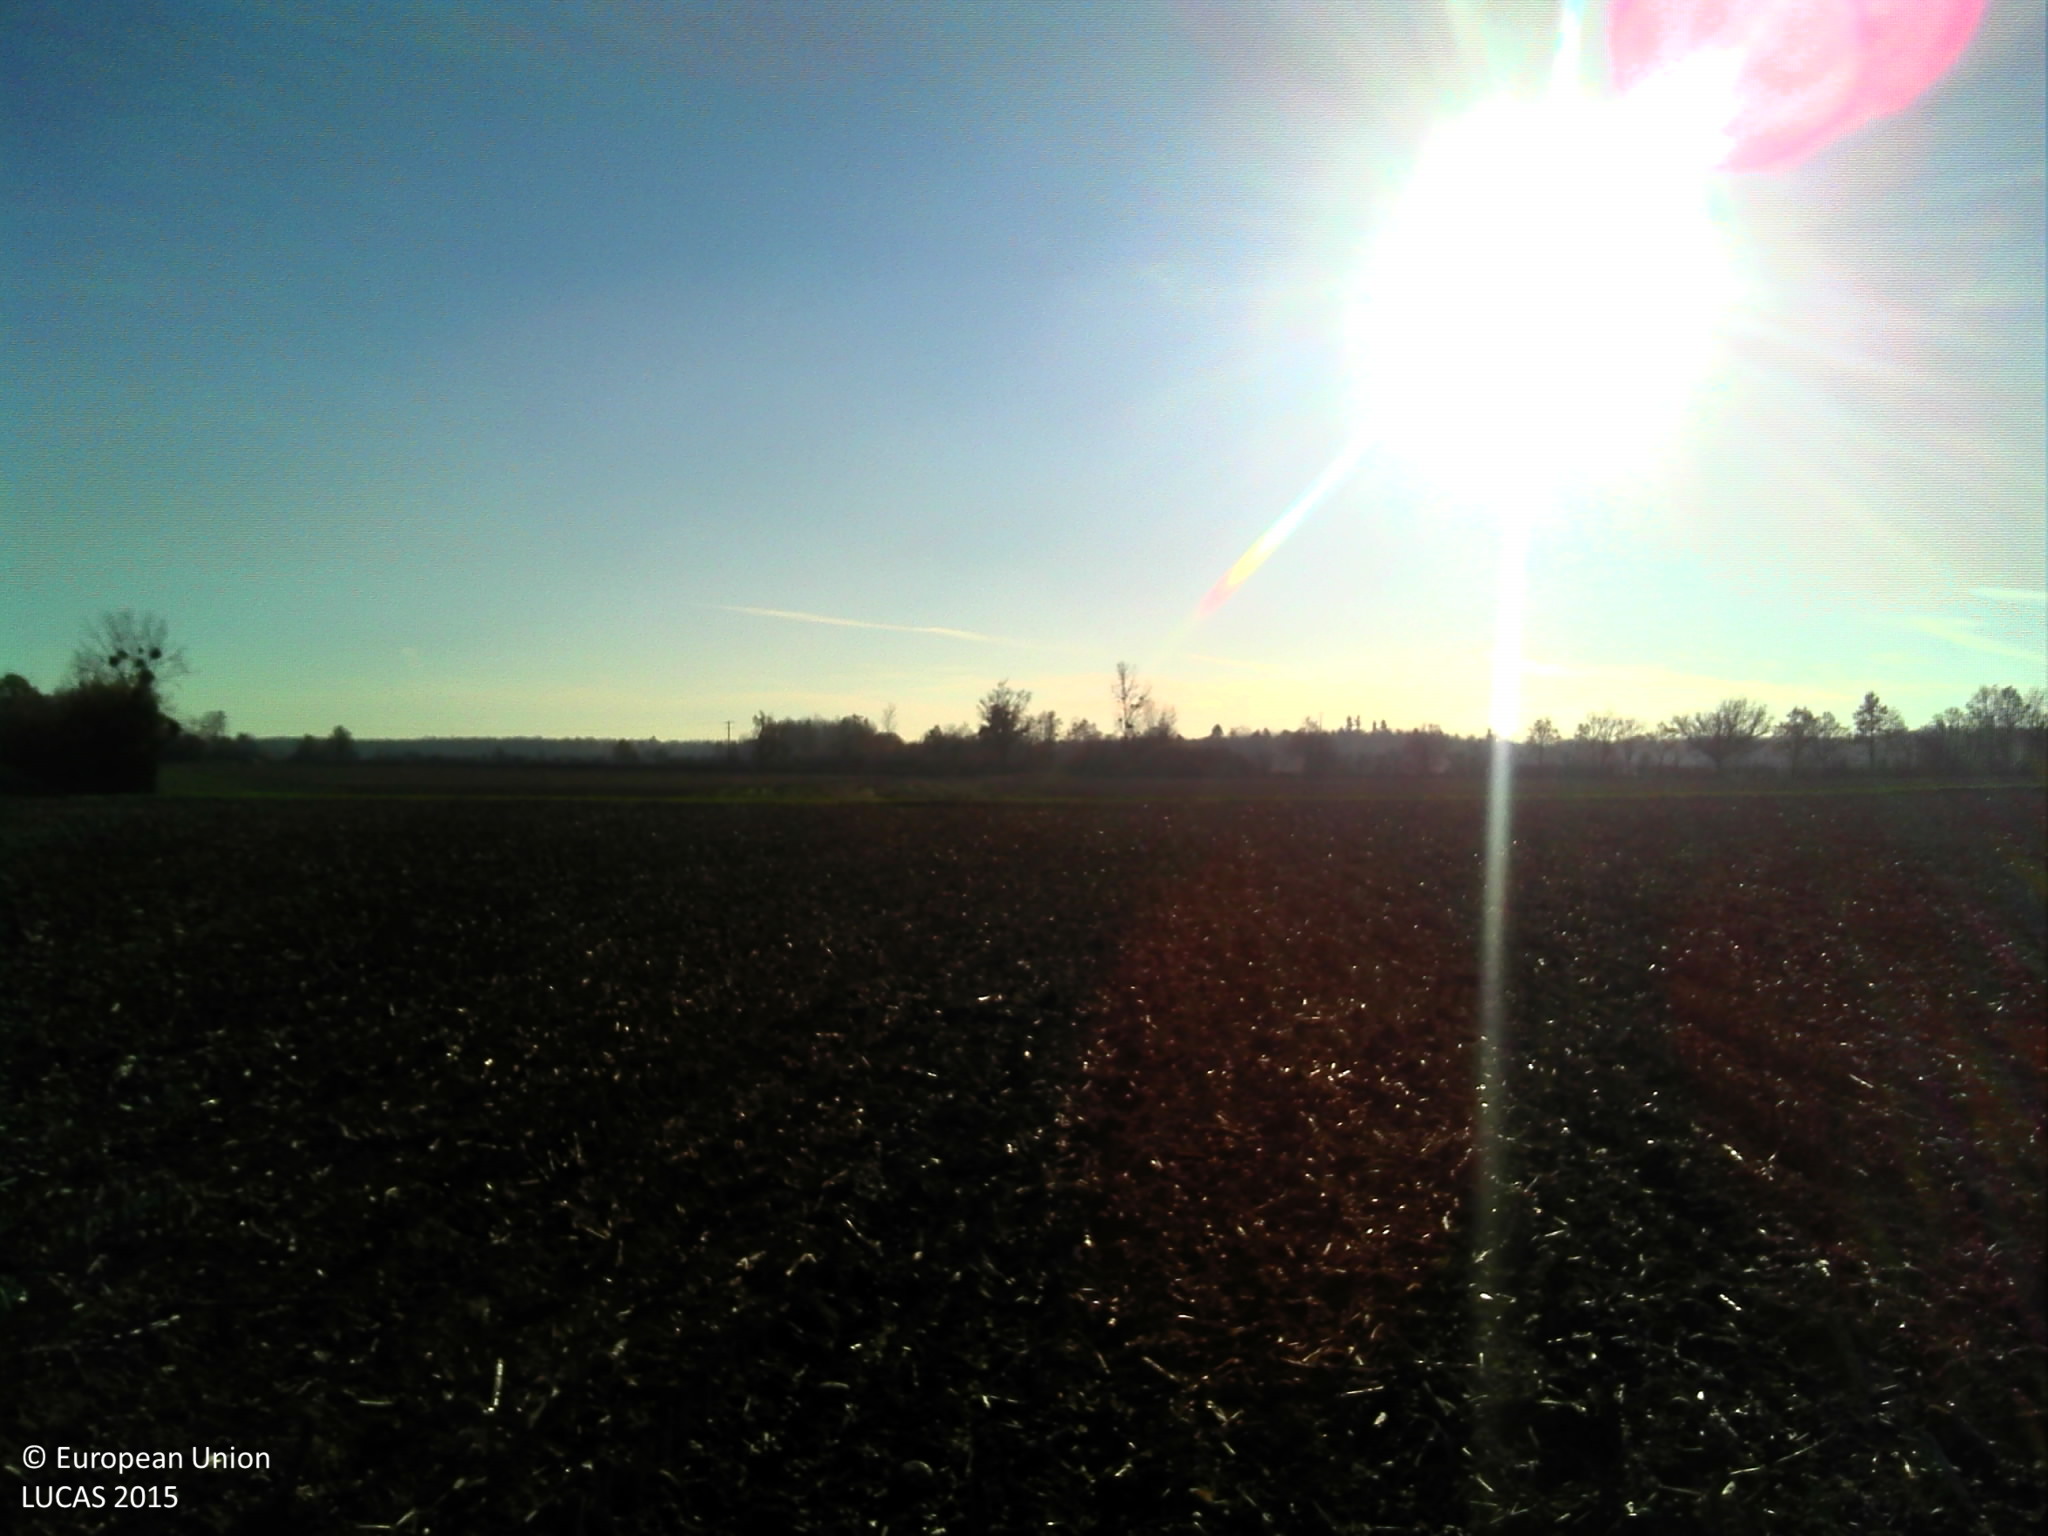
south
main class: Cropland
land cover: Maize
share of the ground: > 75 %
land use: Agriculture (excluding fallow land and kitchen gardens)
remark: Harvested field
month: December
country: FR
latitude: 46.0347
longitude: 4.9770
